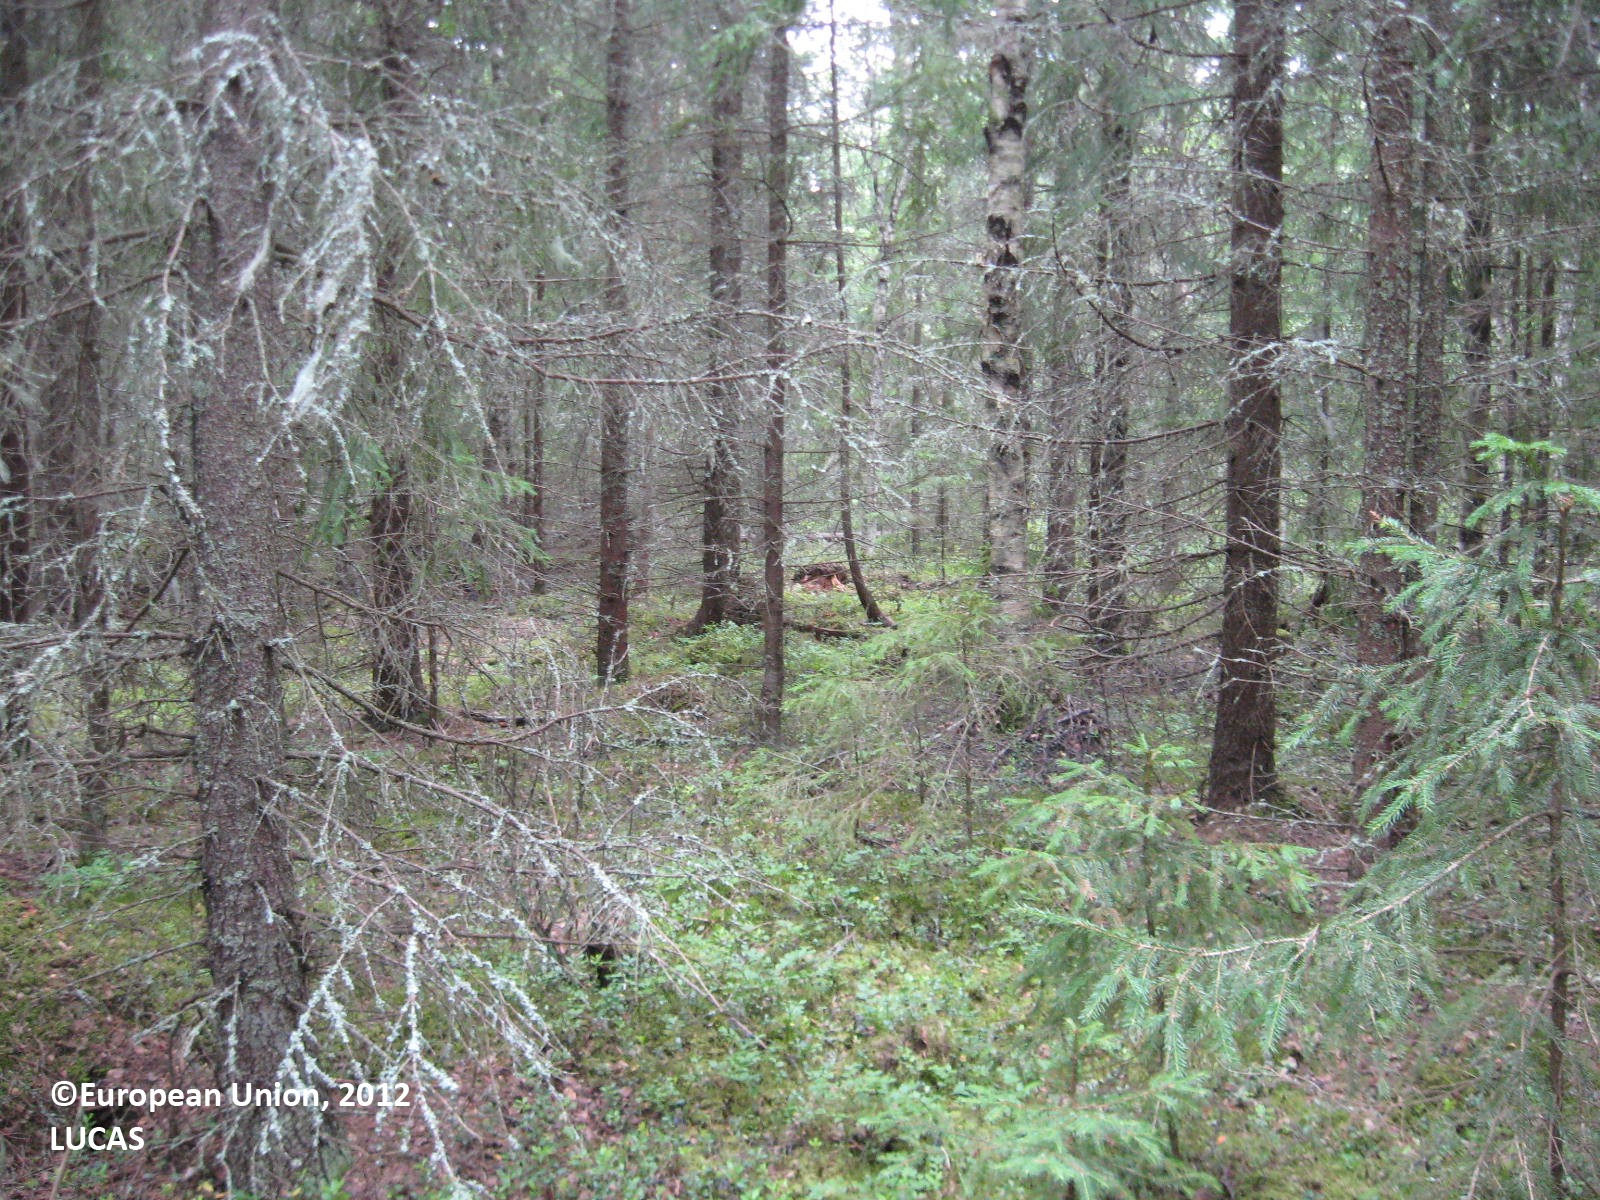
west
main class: Woodland
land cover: Spruce dominated coniferous woodland
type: boreal forest
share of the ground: > 75 %
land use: Forestry
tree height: > 5 m
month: July
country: FI
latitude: 62.5387
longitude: 21.2168
